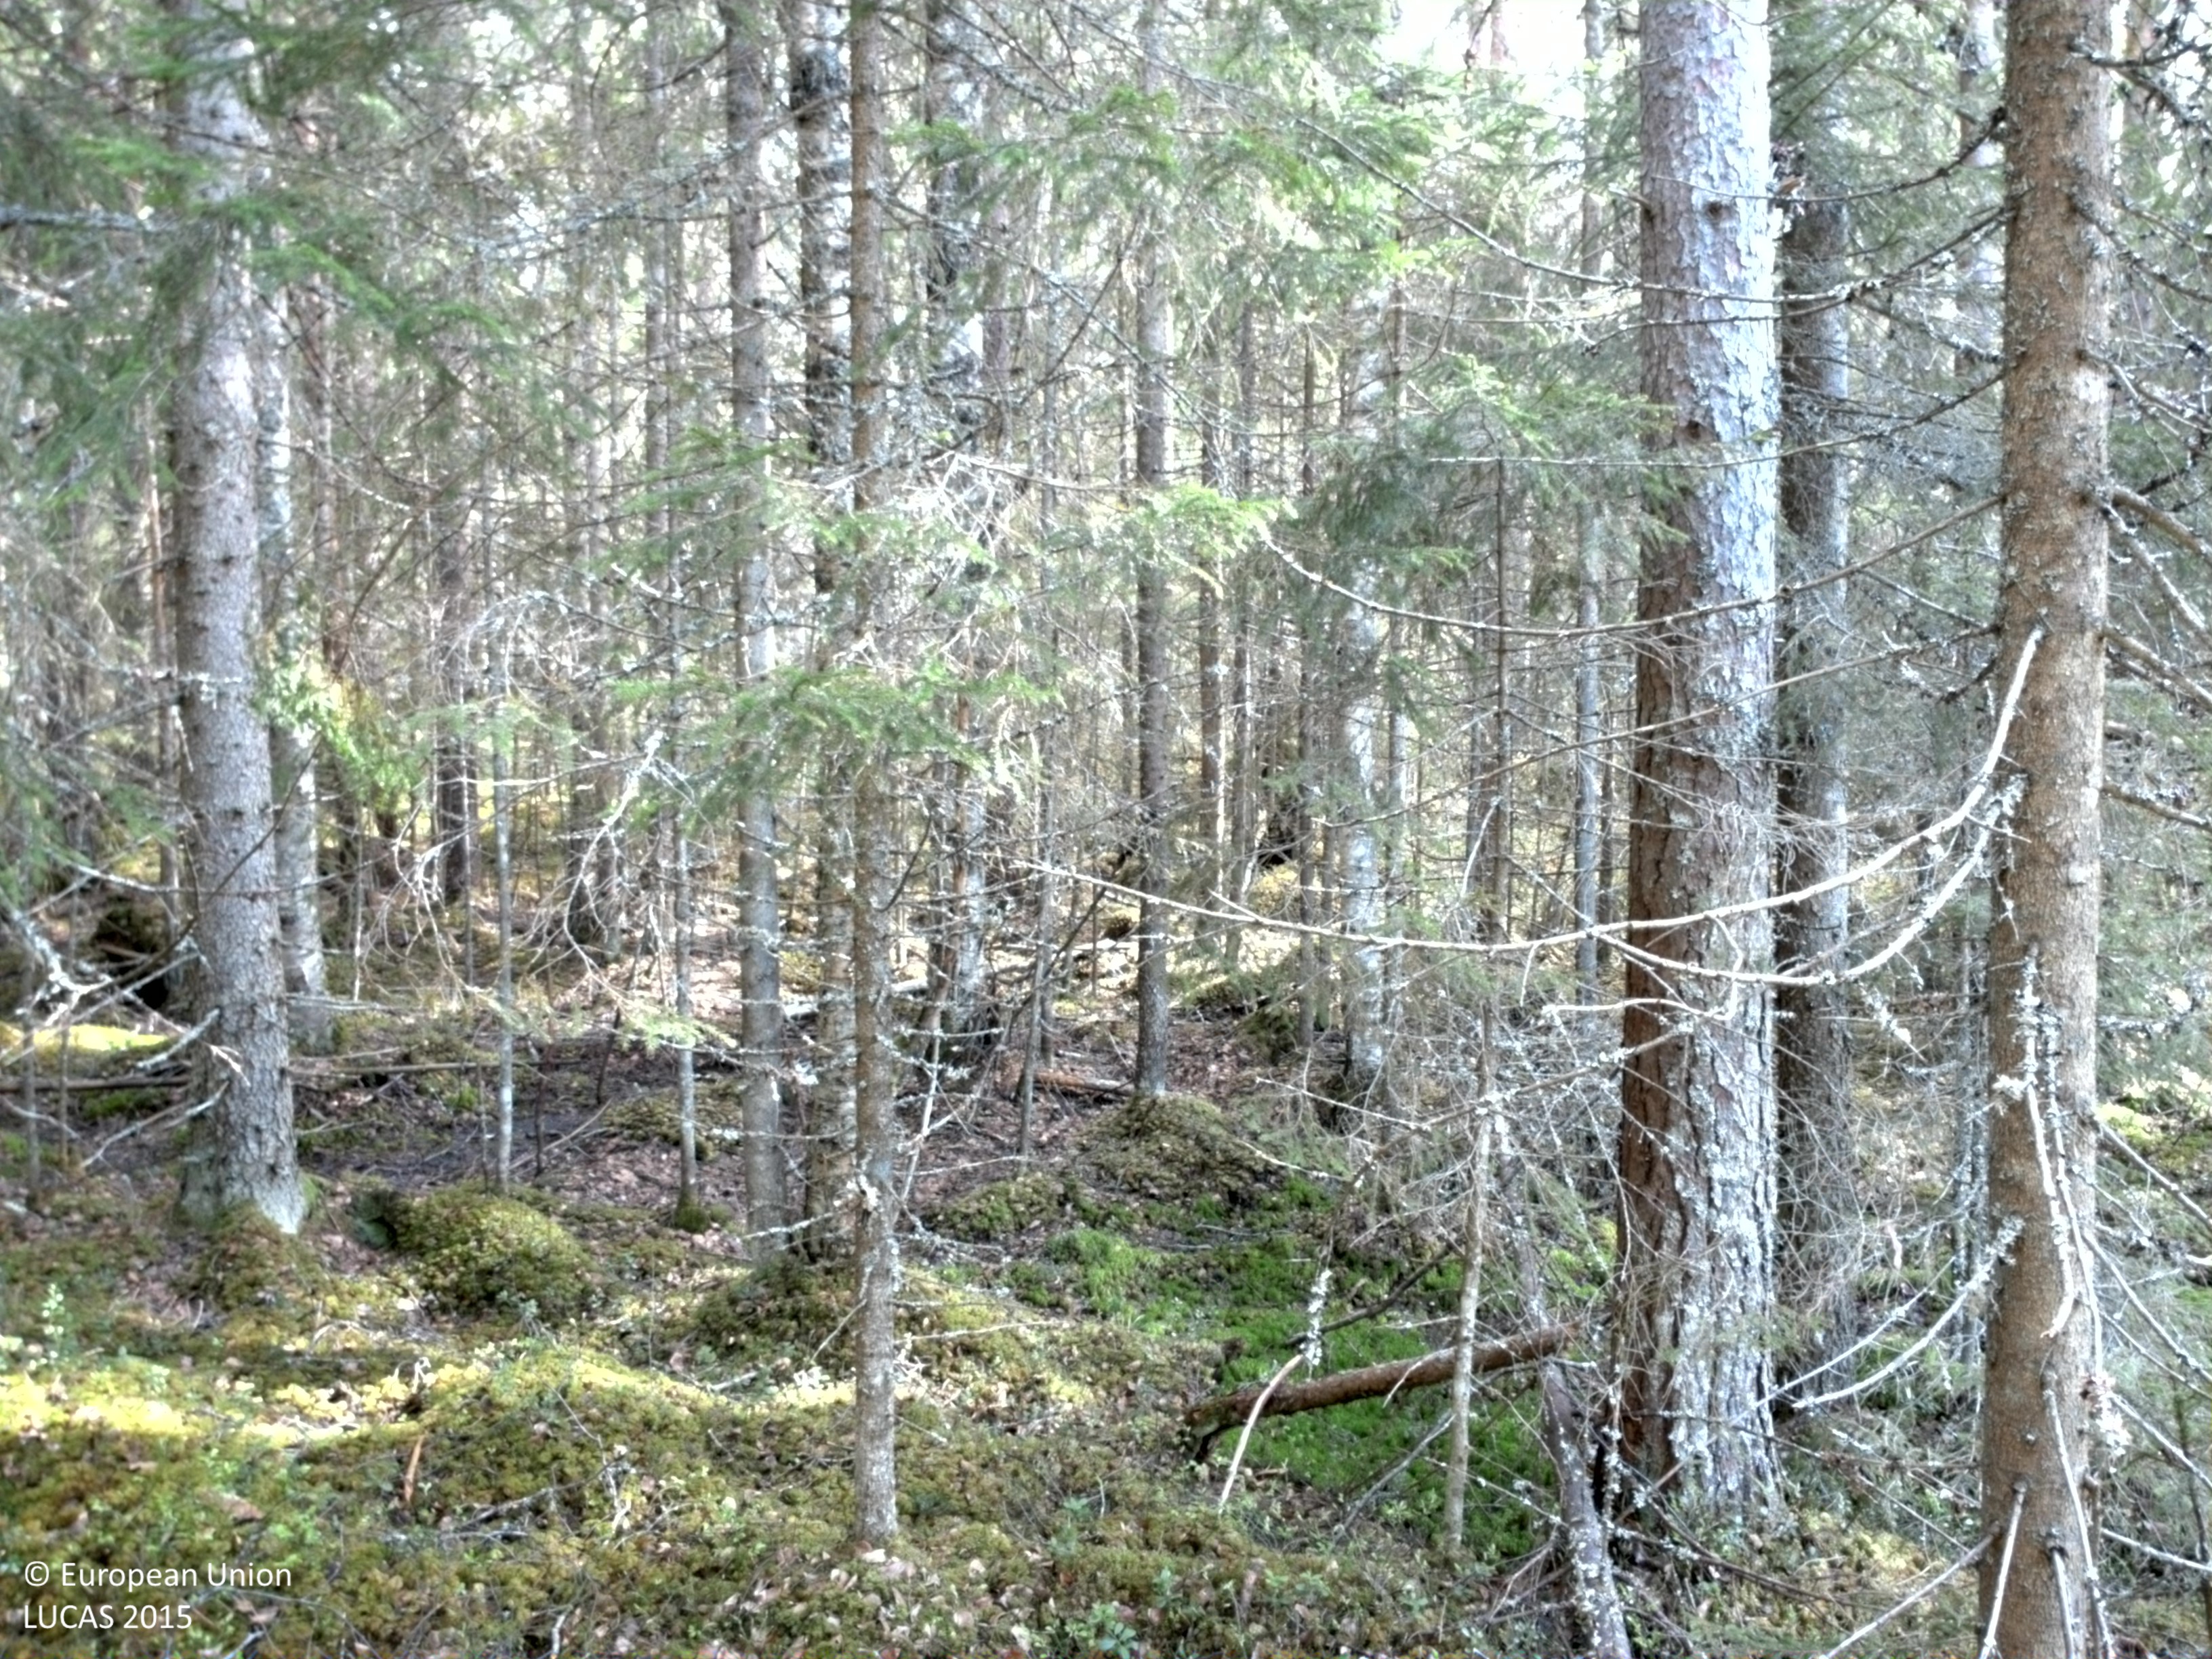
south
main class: Woodland
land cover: Spruce dominated coniferous woodland
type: boreal forest
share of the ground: > 75 %
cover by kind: coniferous forest trees 80 %, shrubs 10 %, herbaceous plants 5 %, lichens and mosses 5 %
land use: Forestry
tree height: > 5 m
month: May
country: SE
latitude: 61.1469
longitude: 15.2798
